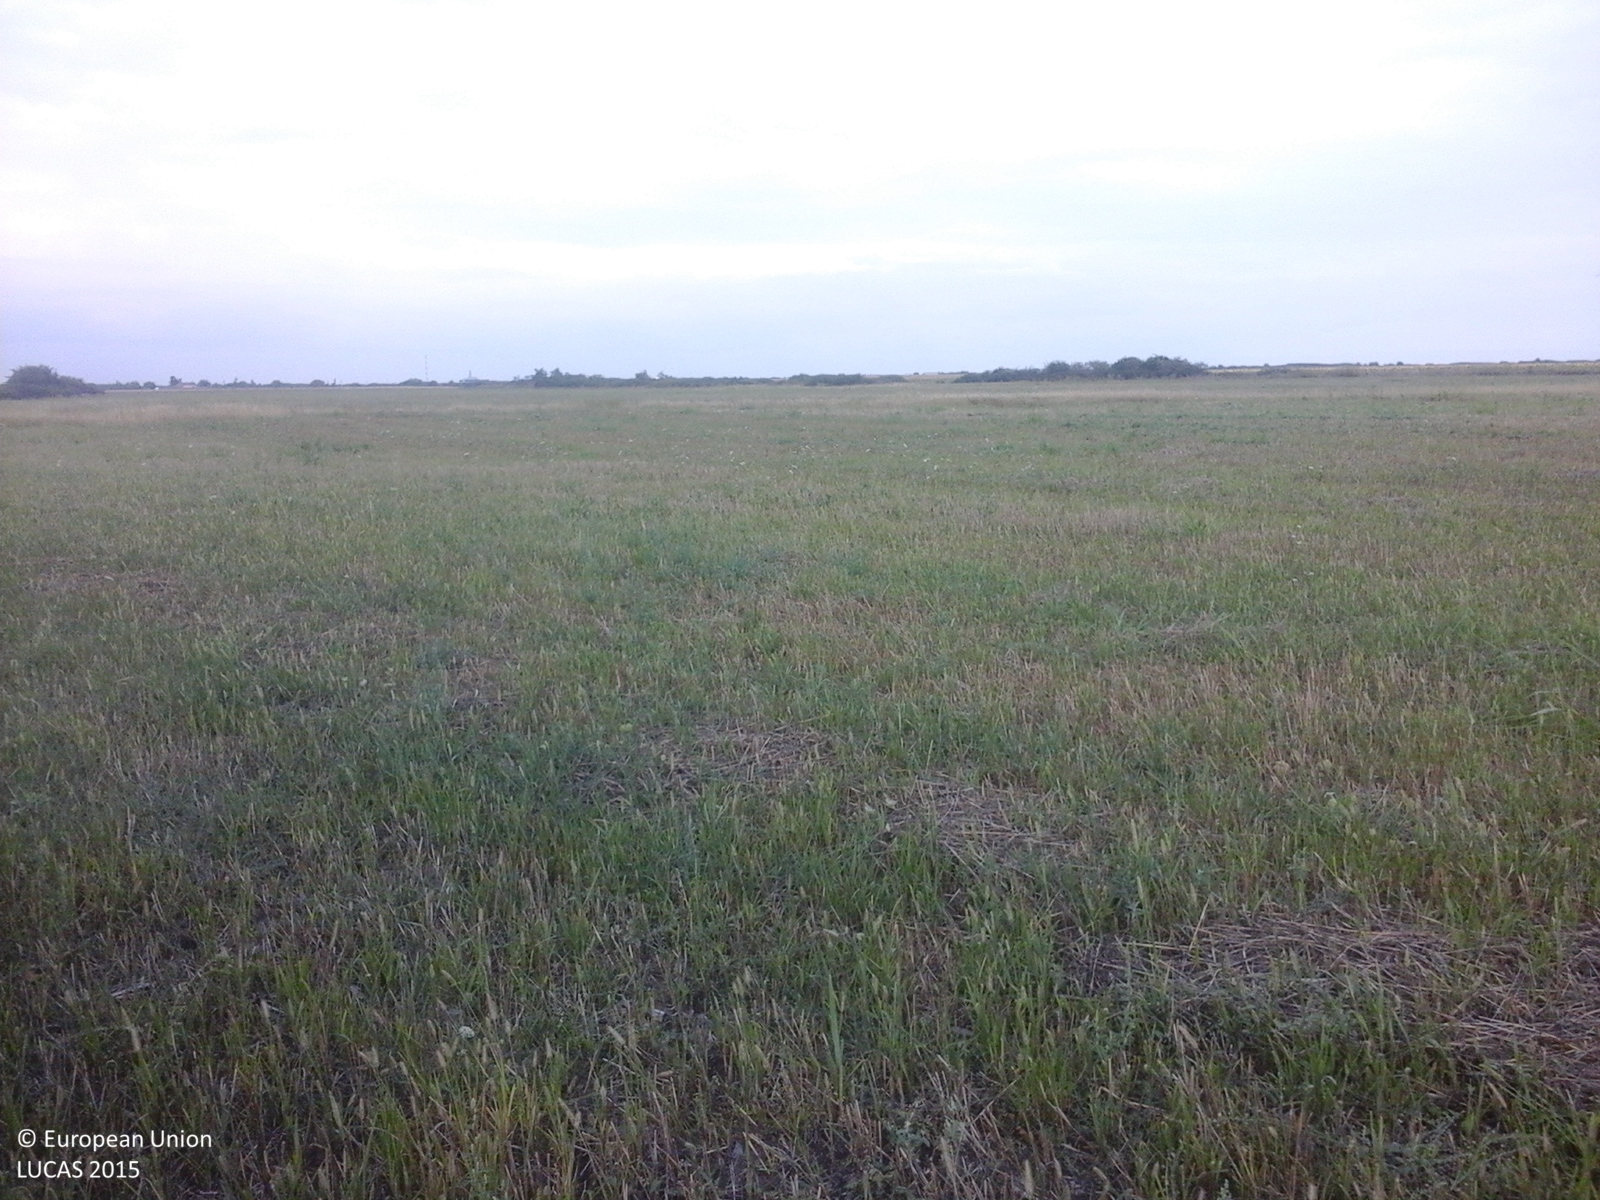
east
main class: Cropland
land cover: Common wheat
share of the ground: 50 - 75 %
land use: Agriculture (excluding fallow land and kitchen gardens)
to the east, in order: Common wheat; Shrubland without tree cover; Ditches and canals; Shrubland without tree cover; Grass margins; Other leguminous and mixtures for fodder
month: August
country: RO
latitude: 45.3407
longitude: 21.2201
